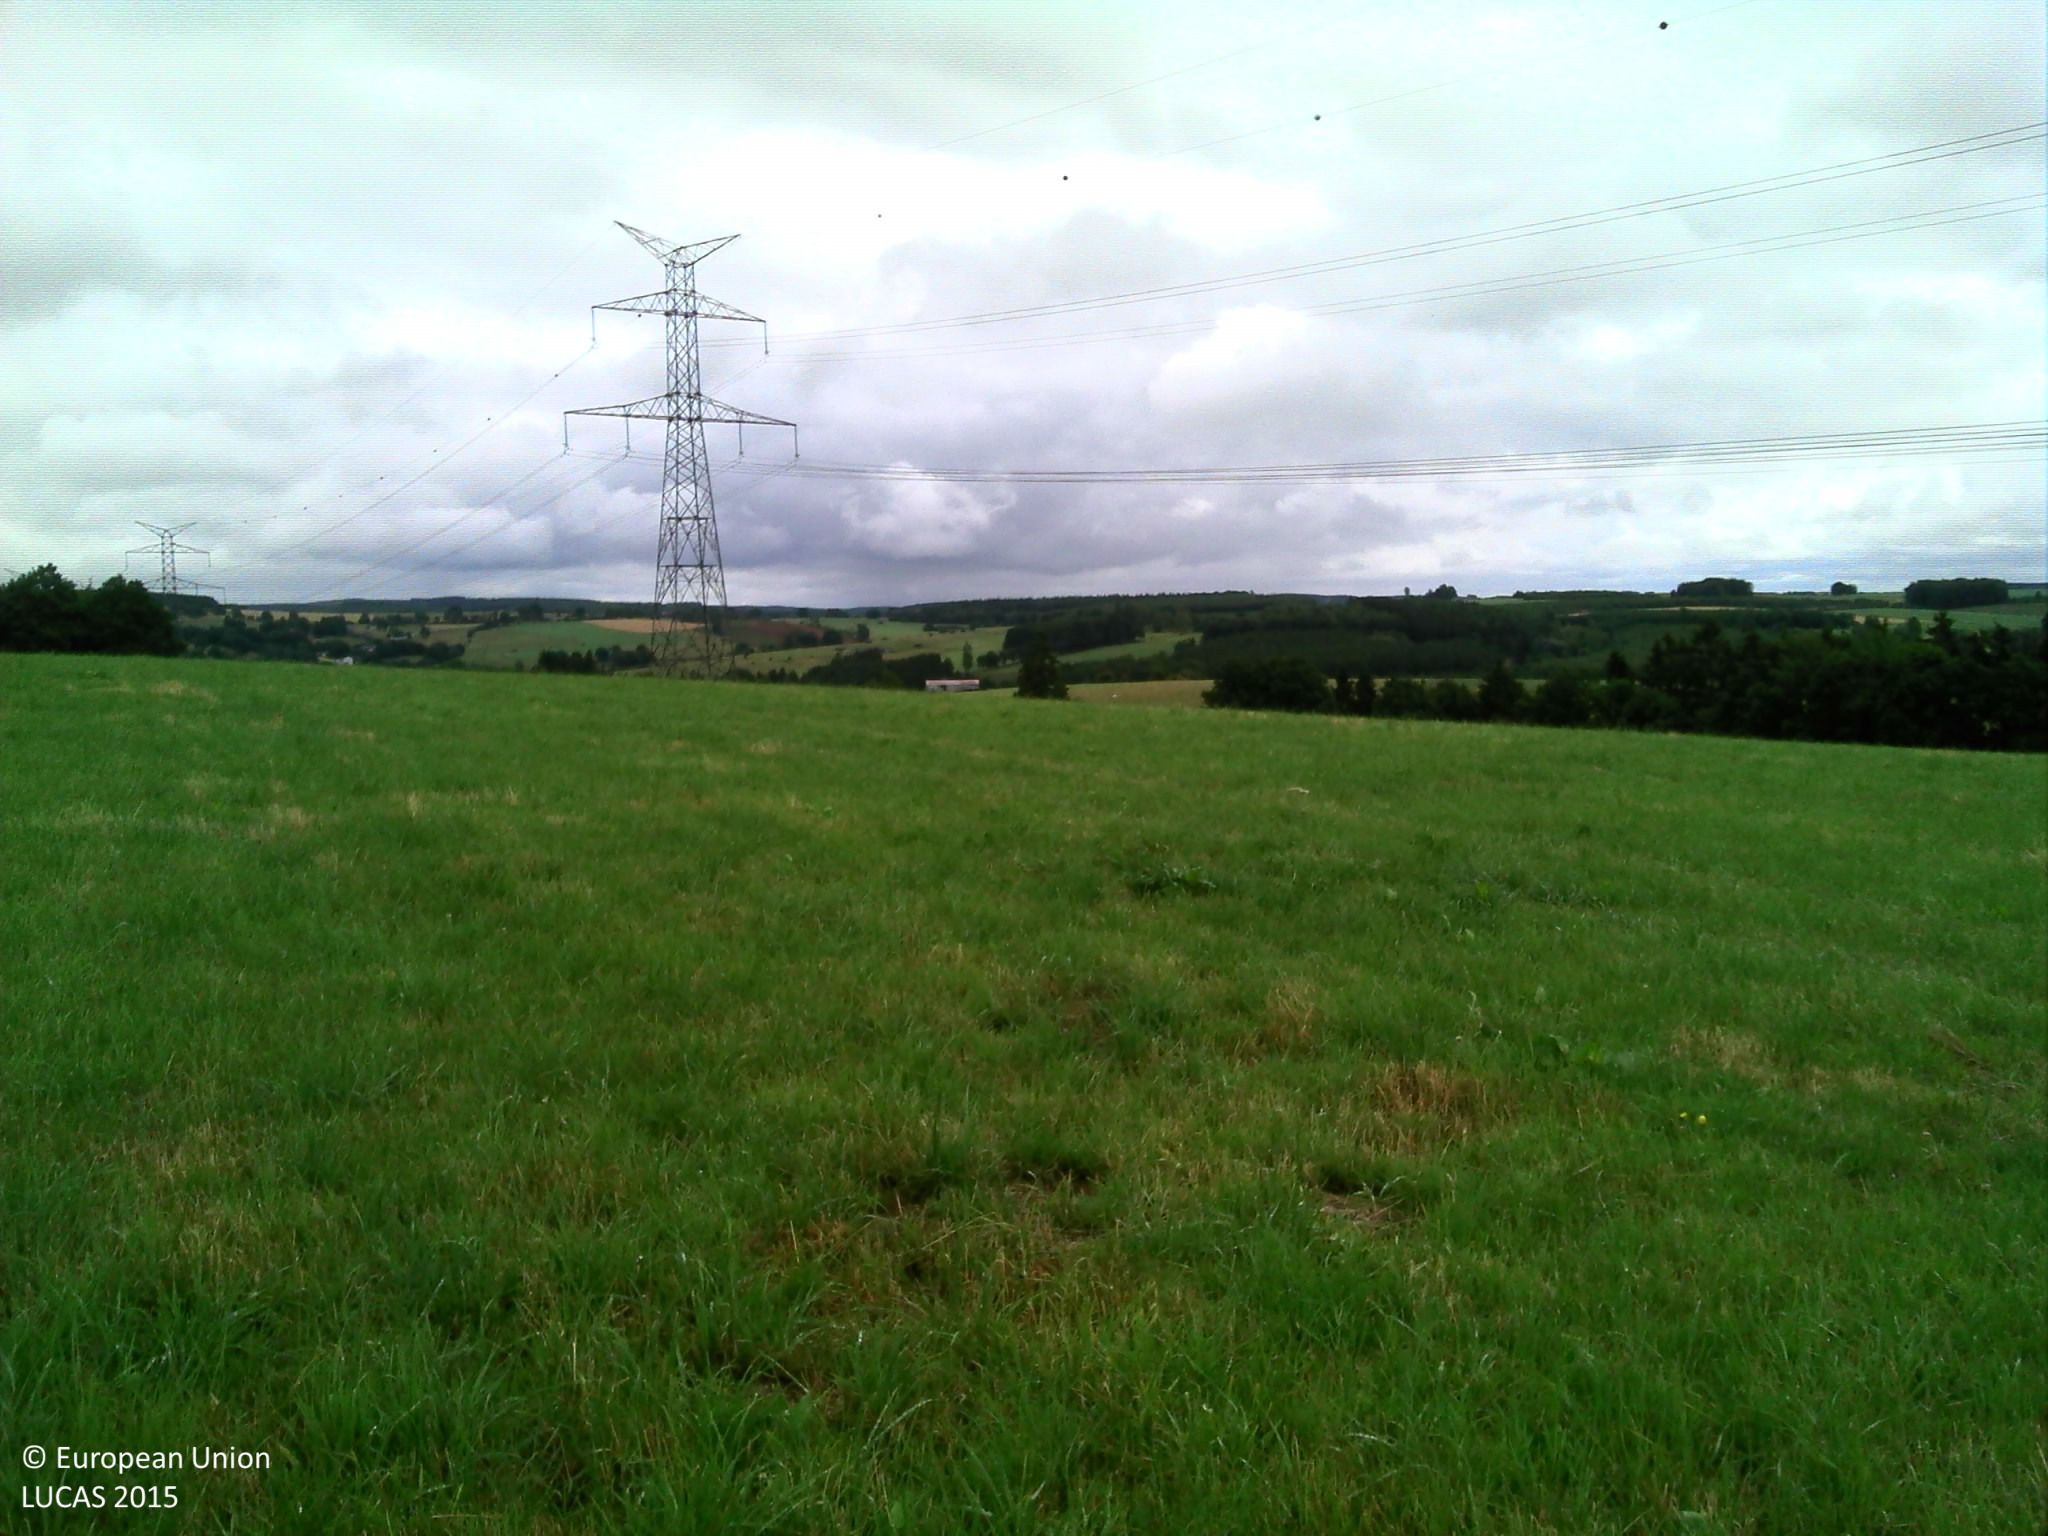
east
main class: Grassland
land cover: Grassland without tree/shrub cover
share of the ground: > 75 %
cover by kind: herbaceous plants 100 %
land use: Agriculture (excluding fallow land and kitchen gardens)
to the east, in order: Grassland without tree/shrub cover; Electric lines; Grassland without tree/shrub cover
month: July
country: BE
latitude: 50.1065
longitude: 5.7902
